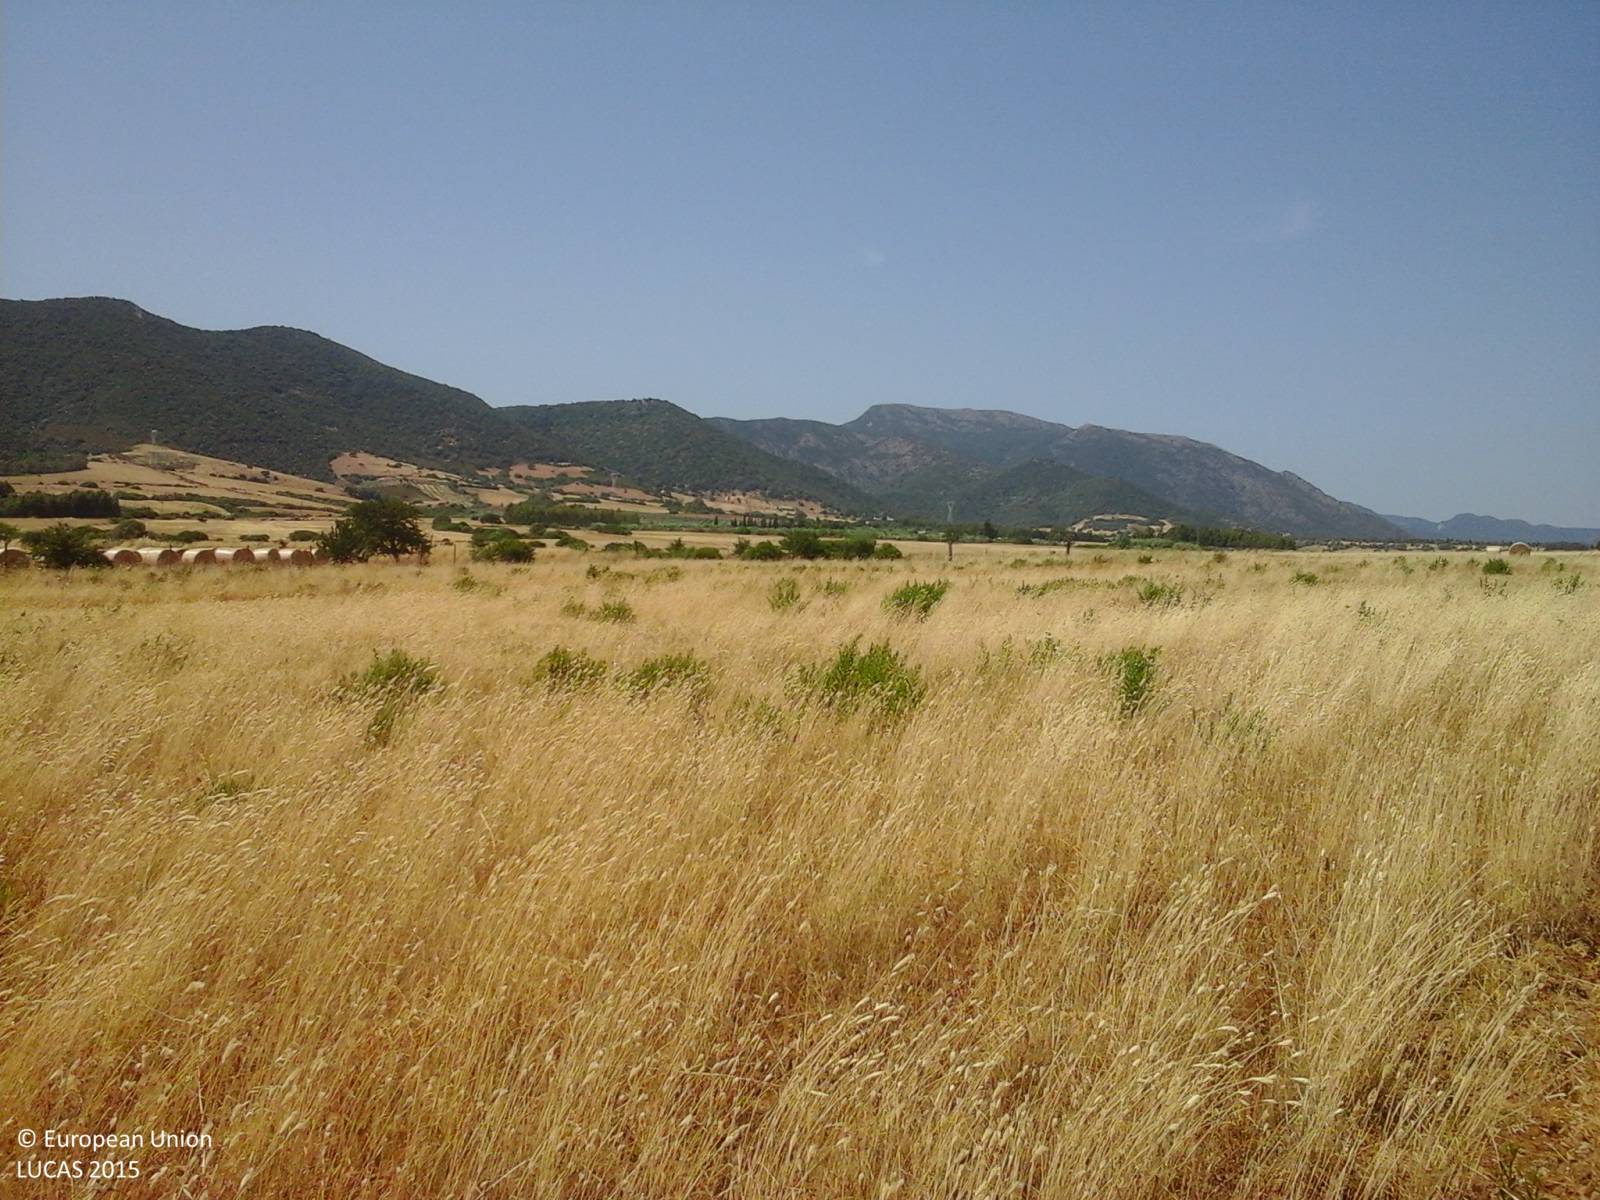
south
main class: Grassland
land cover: Spontaneously vegetated surfaces
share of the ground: > 75 %
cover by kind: herbaceous plants 85 %, unconsolidated bare surface 15 %
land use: Agriculture (excluding fallow land and kitchen gardens)
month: June
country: IT
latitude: 39.2639
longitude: 8.8136
